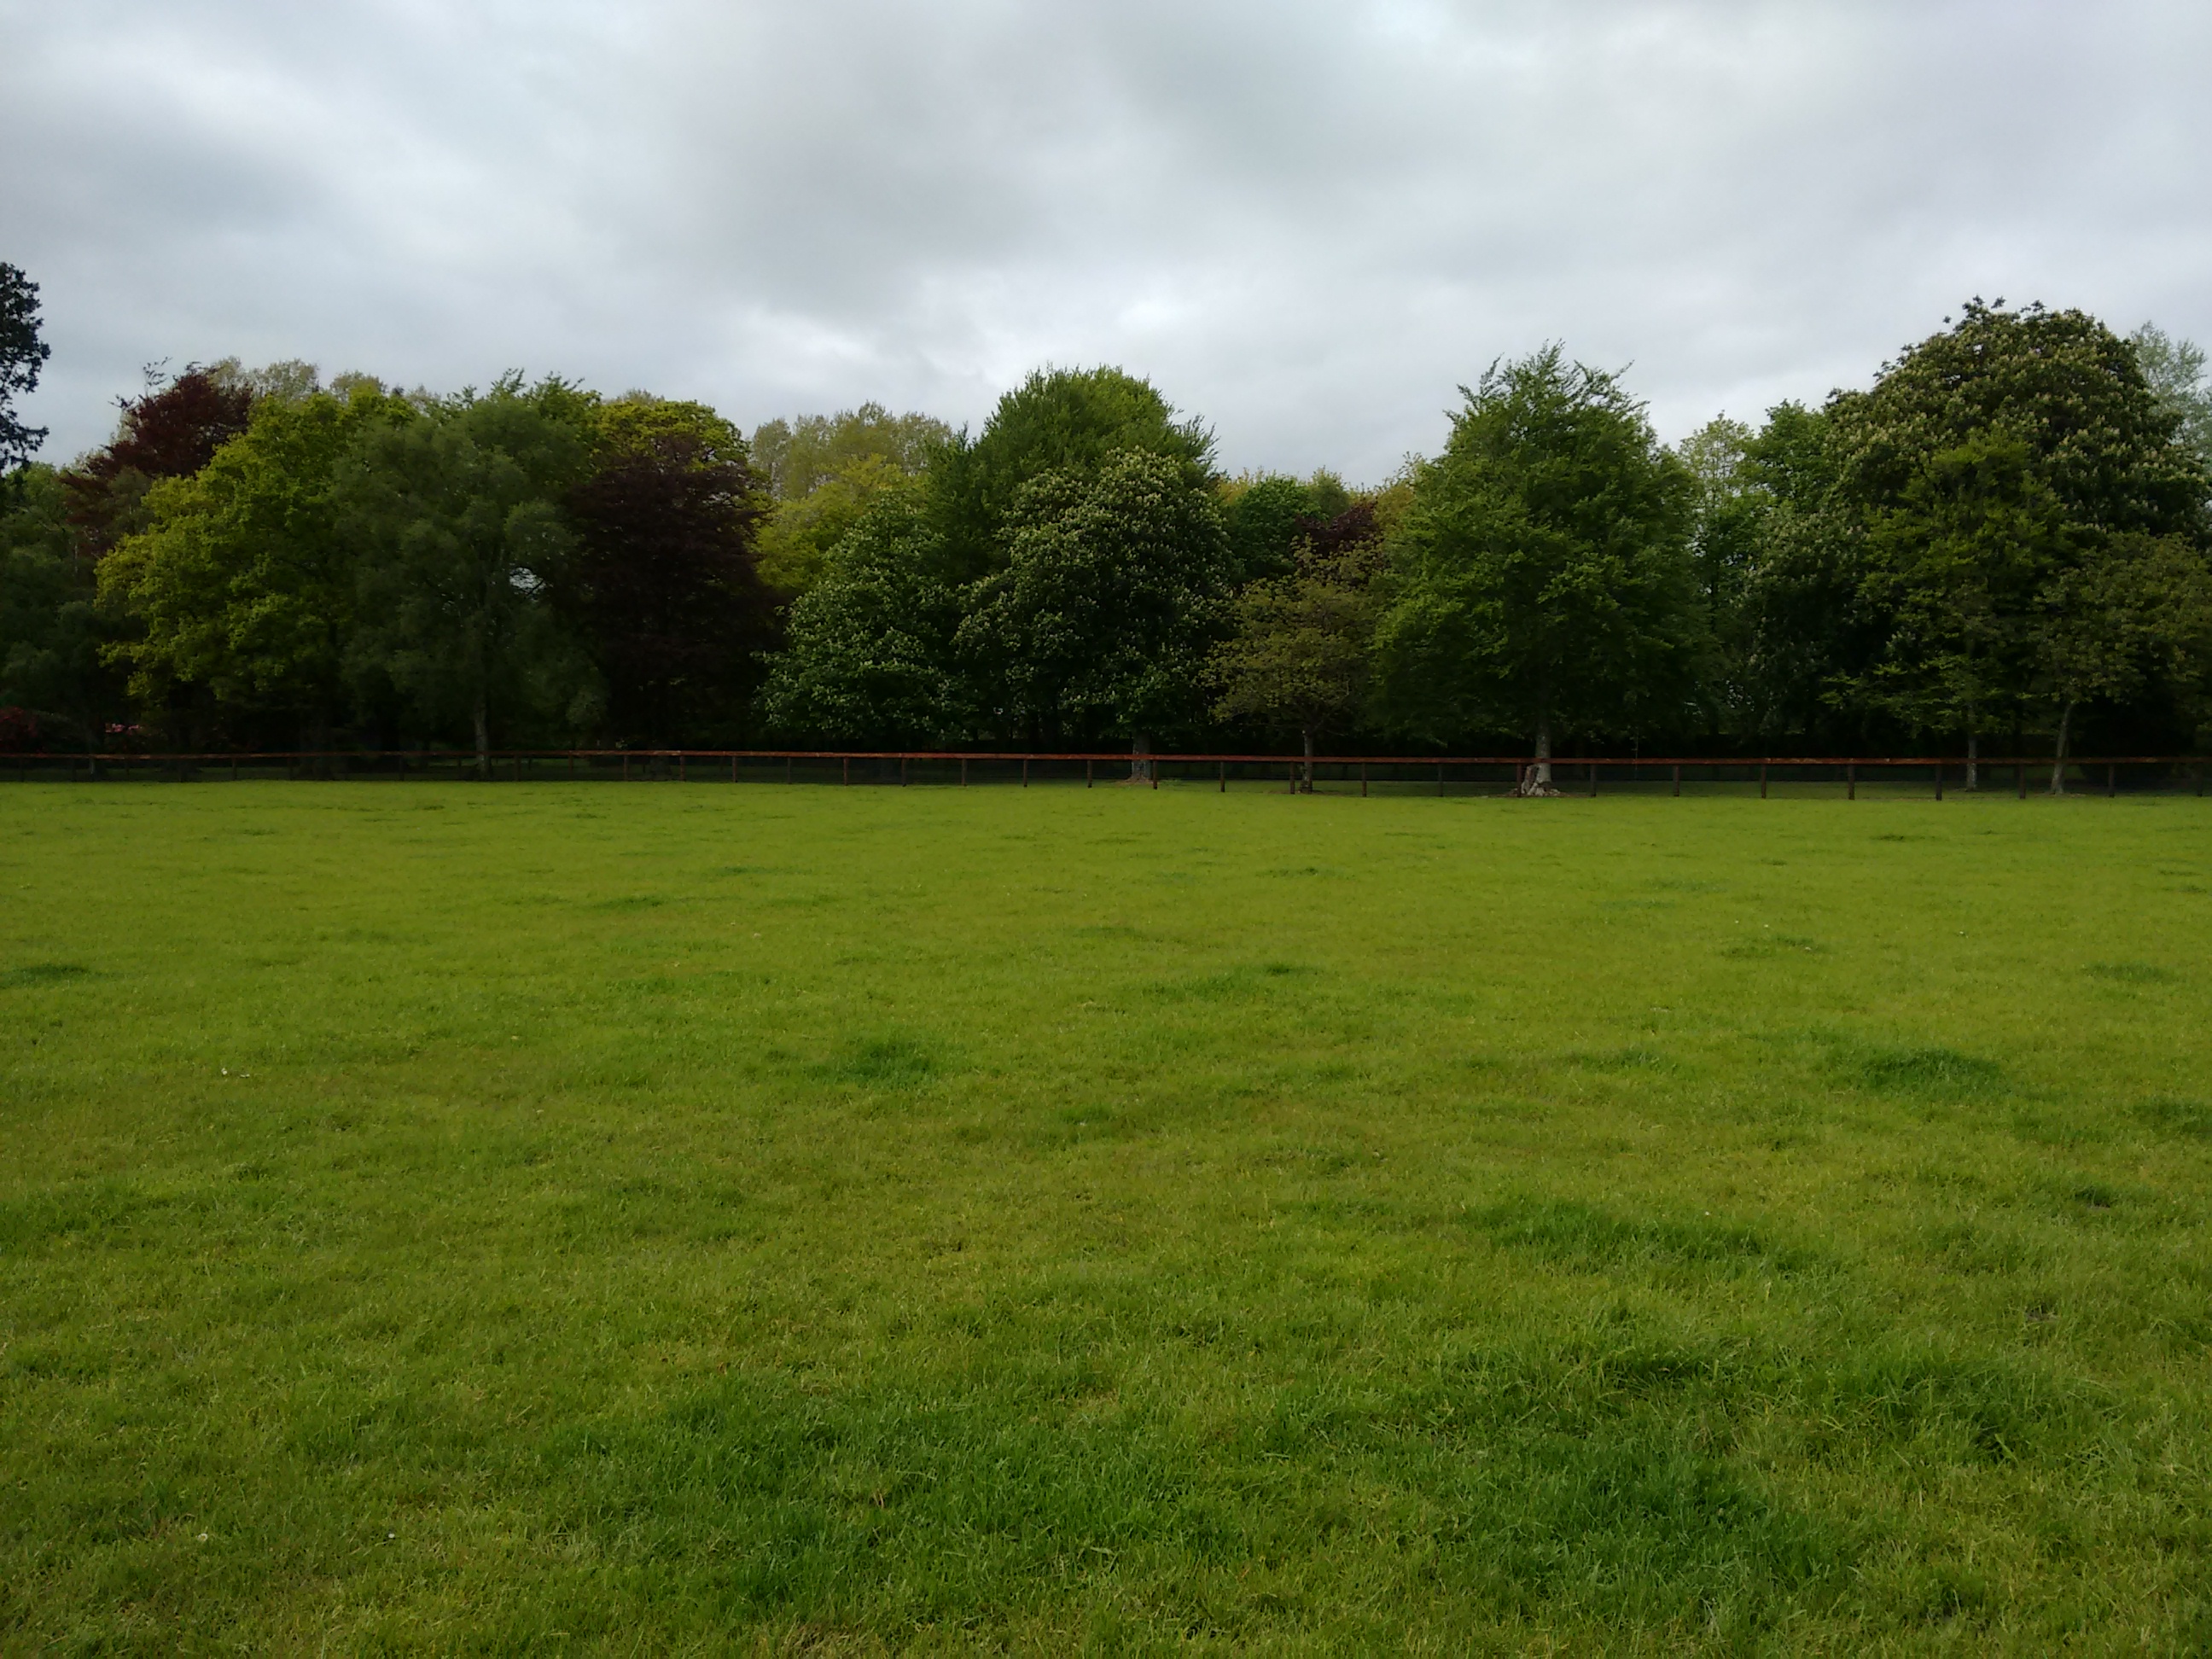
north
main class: Grassland
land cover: Grassland without tree/shrub cover
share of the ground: > 75 %
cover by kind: herbaceous plants 95 %, unconsolidated bare surface 5 %
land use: Agriculture (excluding fallow land and kitchen gardens)
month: May
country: IE
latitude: 53.4251
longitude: -6.7016
